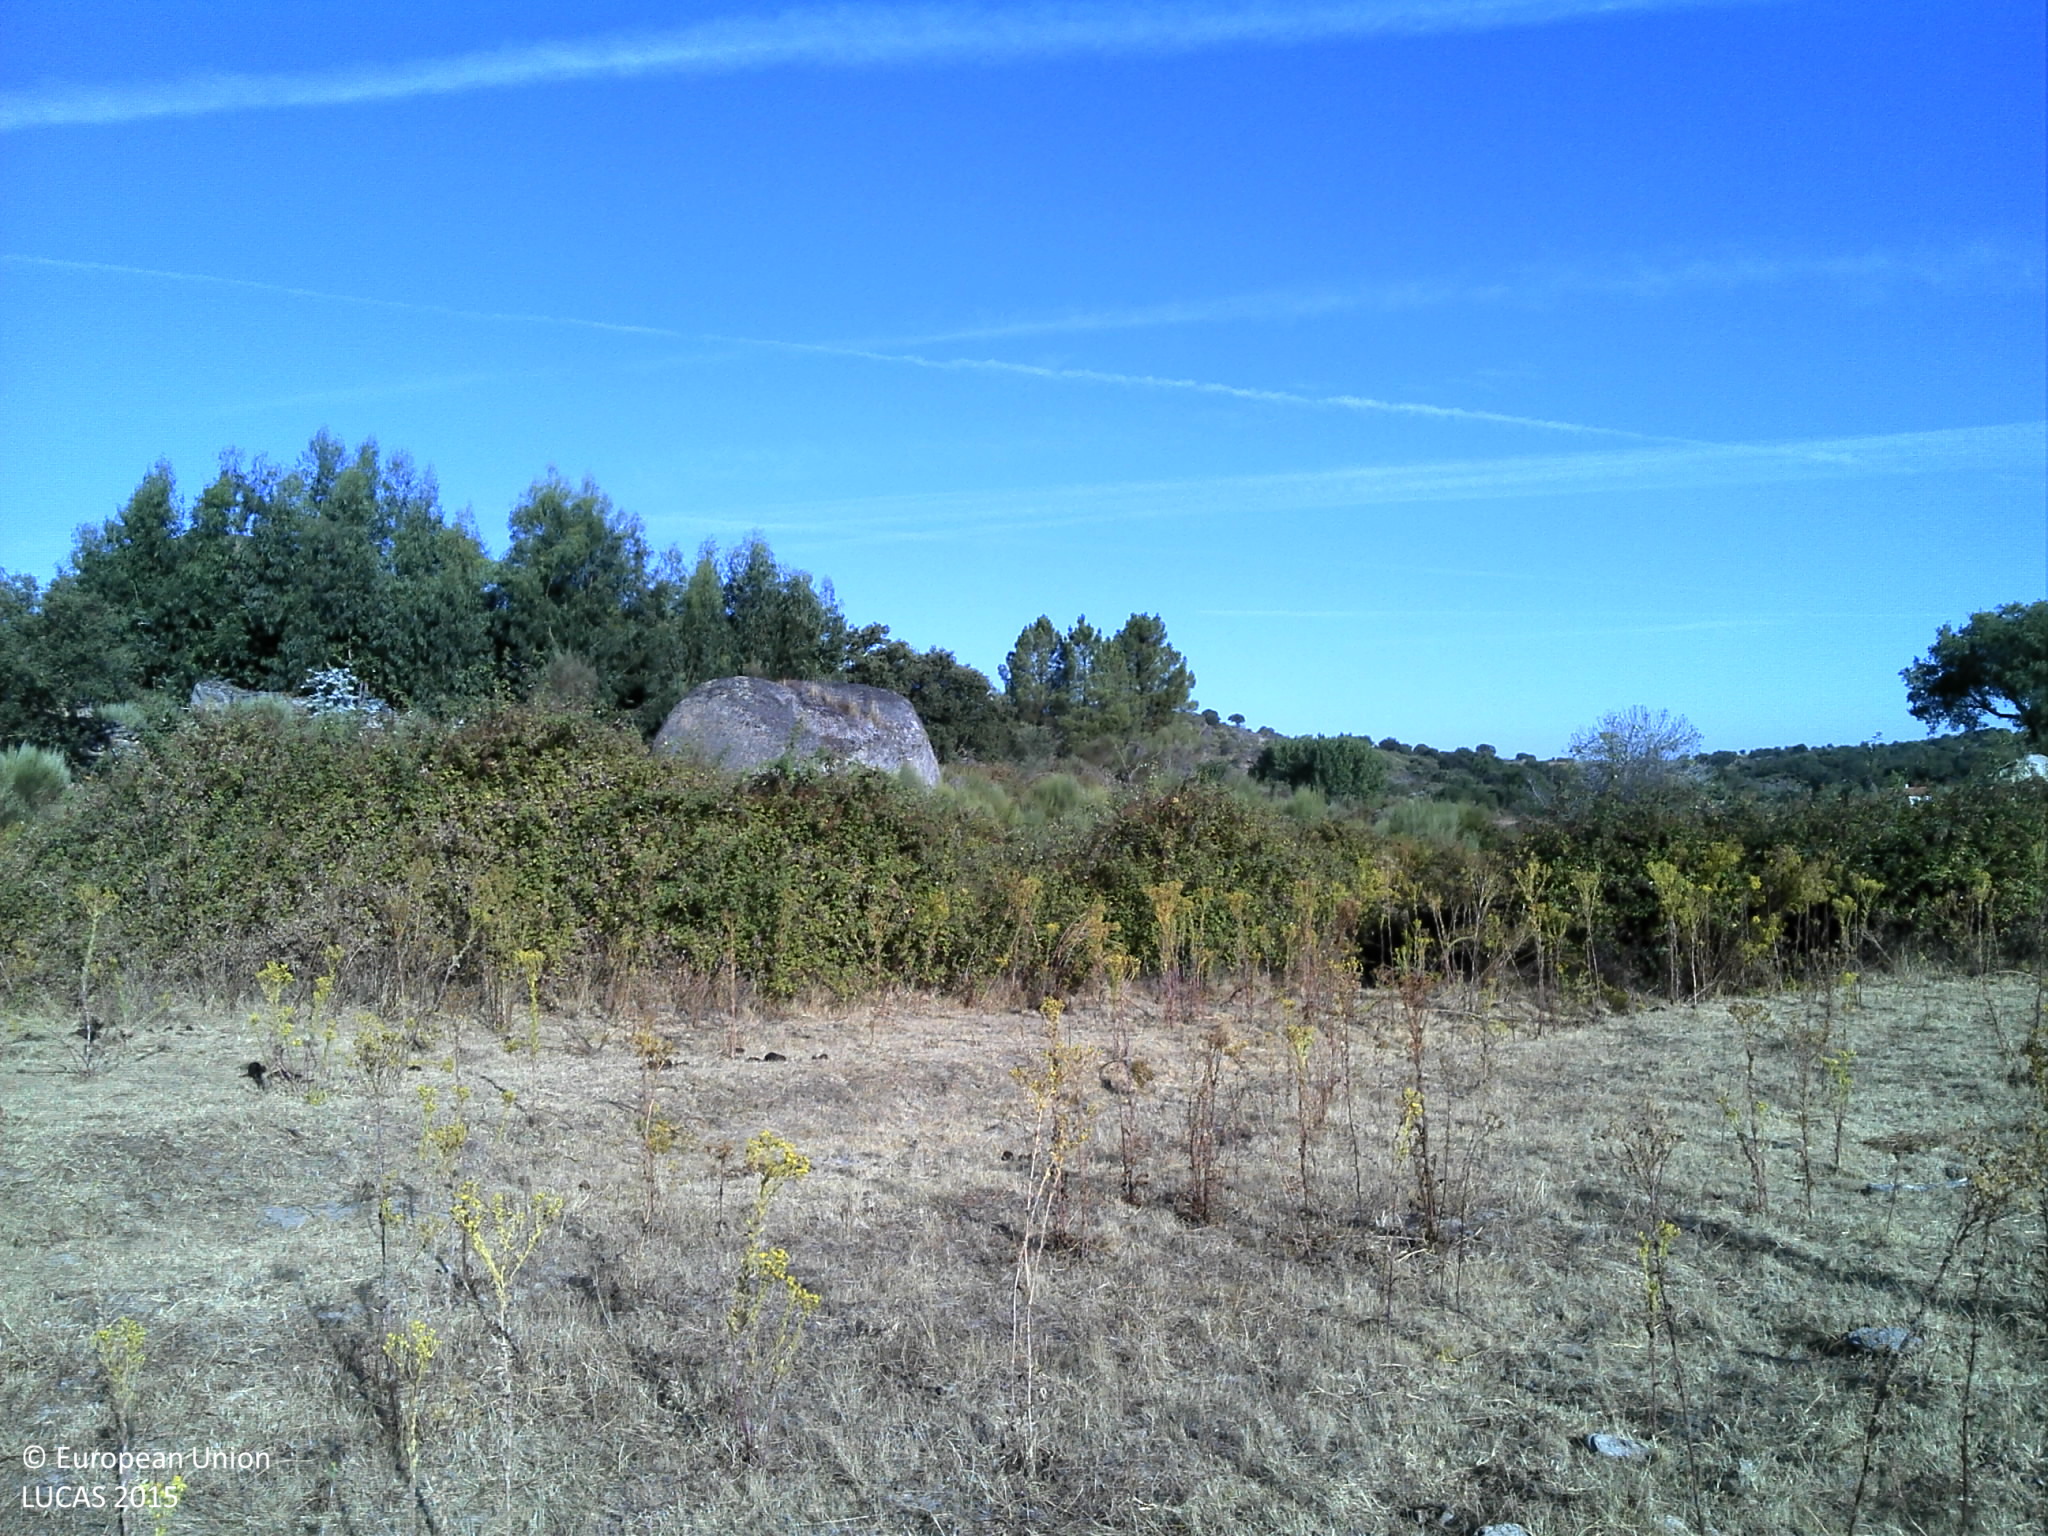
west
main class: Grassland
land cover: Grassland with sparse tree/shrub cover
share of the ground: 50 - 75 %
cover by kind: herbaceous plants 55 %, unconsolidated bare surface 35 %, broadleaved forest trees 5 %, shrubs 5 %
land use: Agriculture (excluding fallow land and kitchen gardens)
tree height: < 5 m
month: August
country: PT
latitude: 39.4702
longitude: -7.4223
